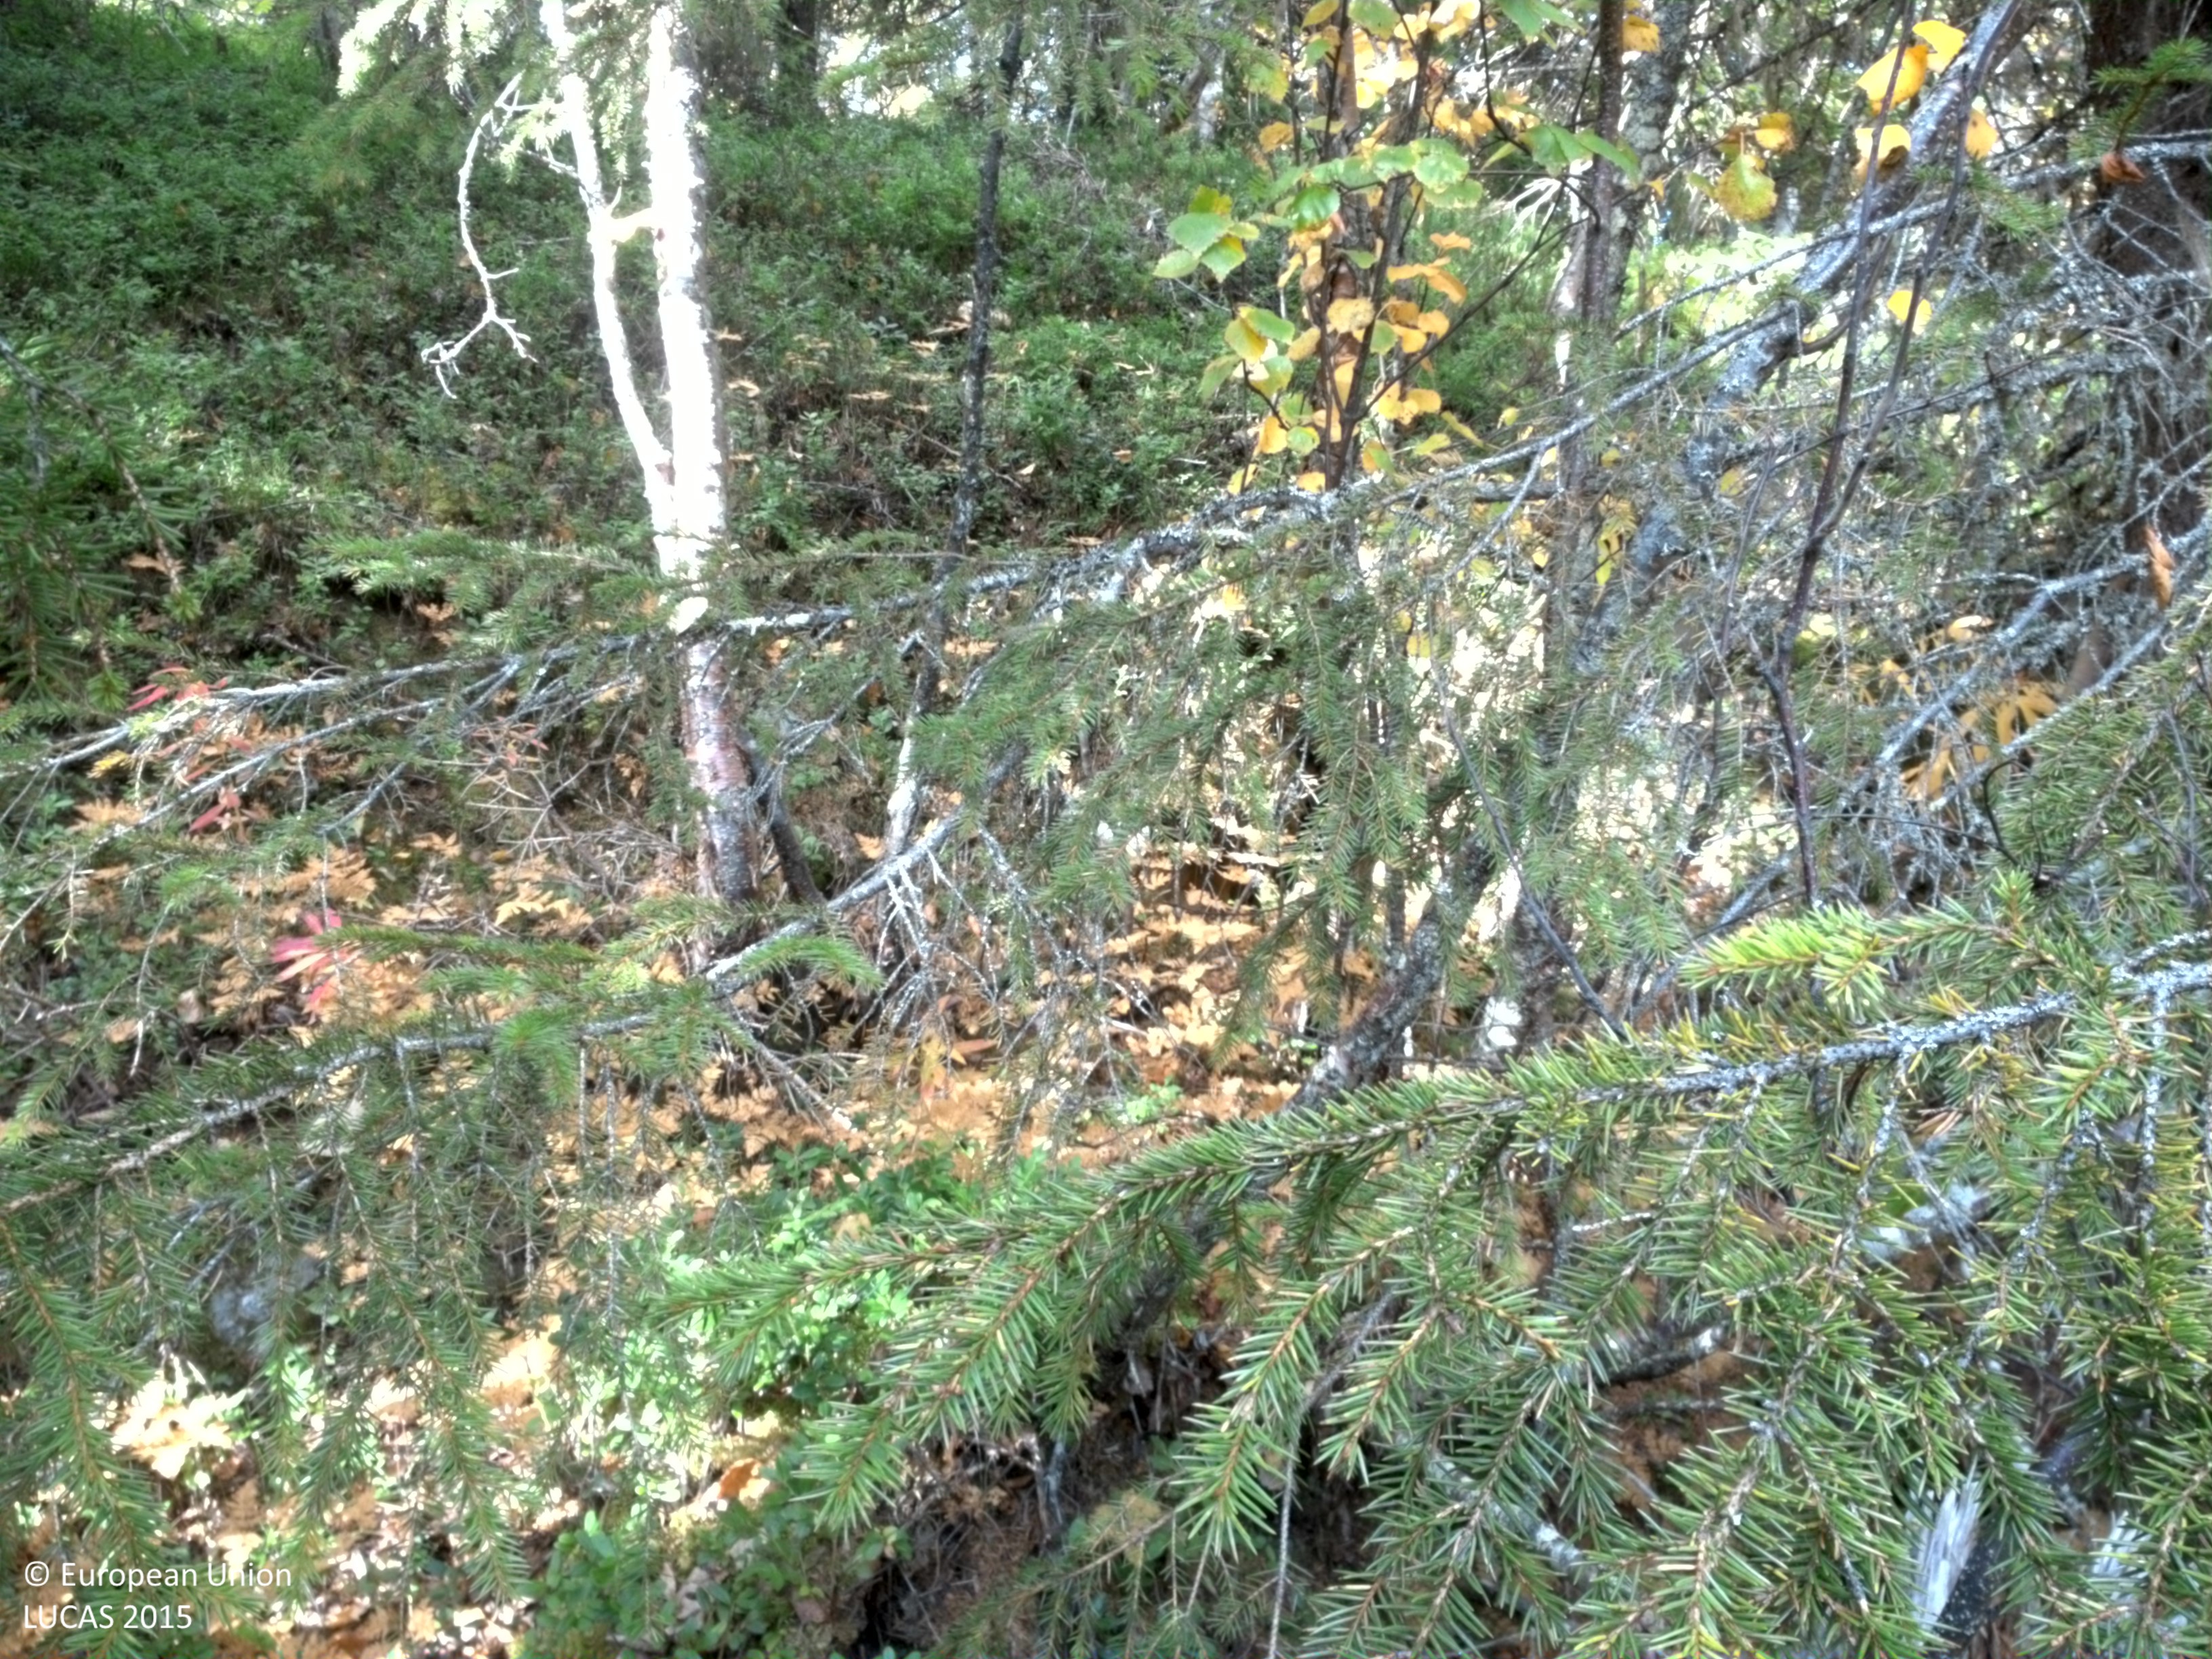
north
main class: Woodland
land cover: Spruce dominated mixed woodland
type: boreal forest
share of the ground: 25 - 50 %
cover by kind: shrubs 40 %, coniferous forest trees 20 %, broadleaved forest trees 15 %, herbaceous plants 15 %, lichens and mosses 10 %
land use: Forestry
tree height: > 5 m
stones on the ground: < 10 %
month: September
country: SE
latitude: 65.2828
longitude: 16.8851
